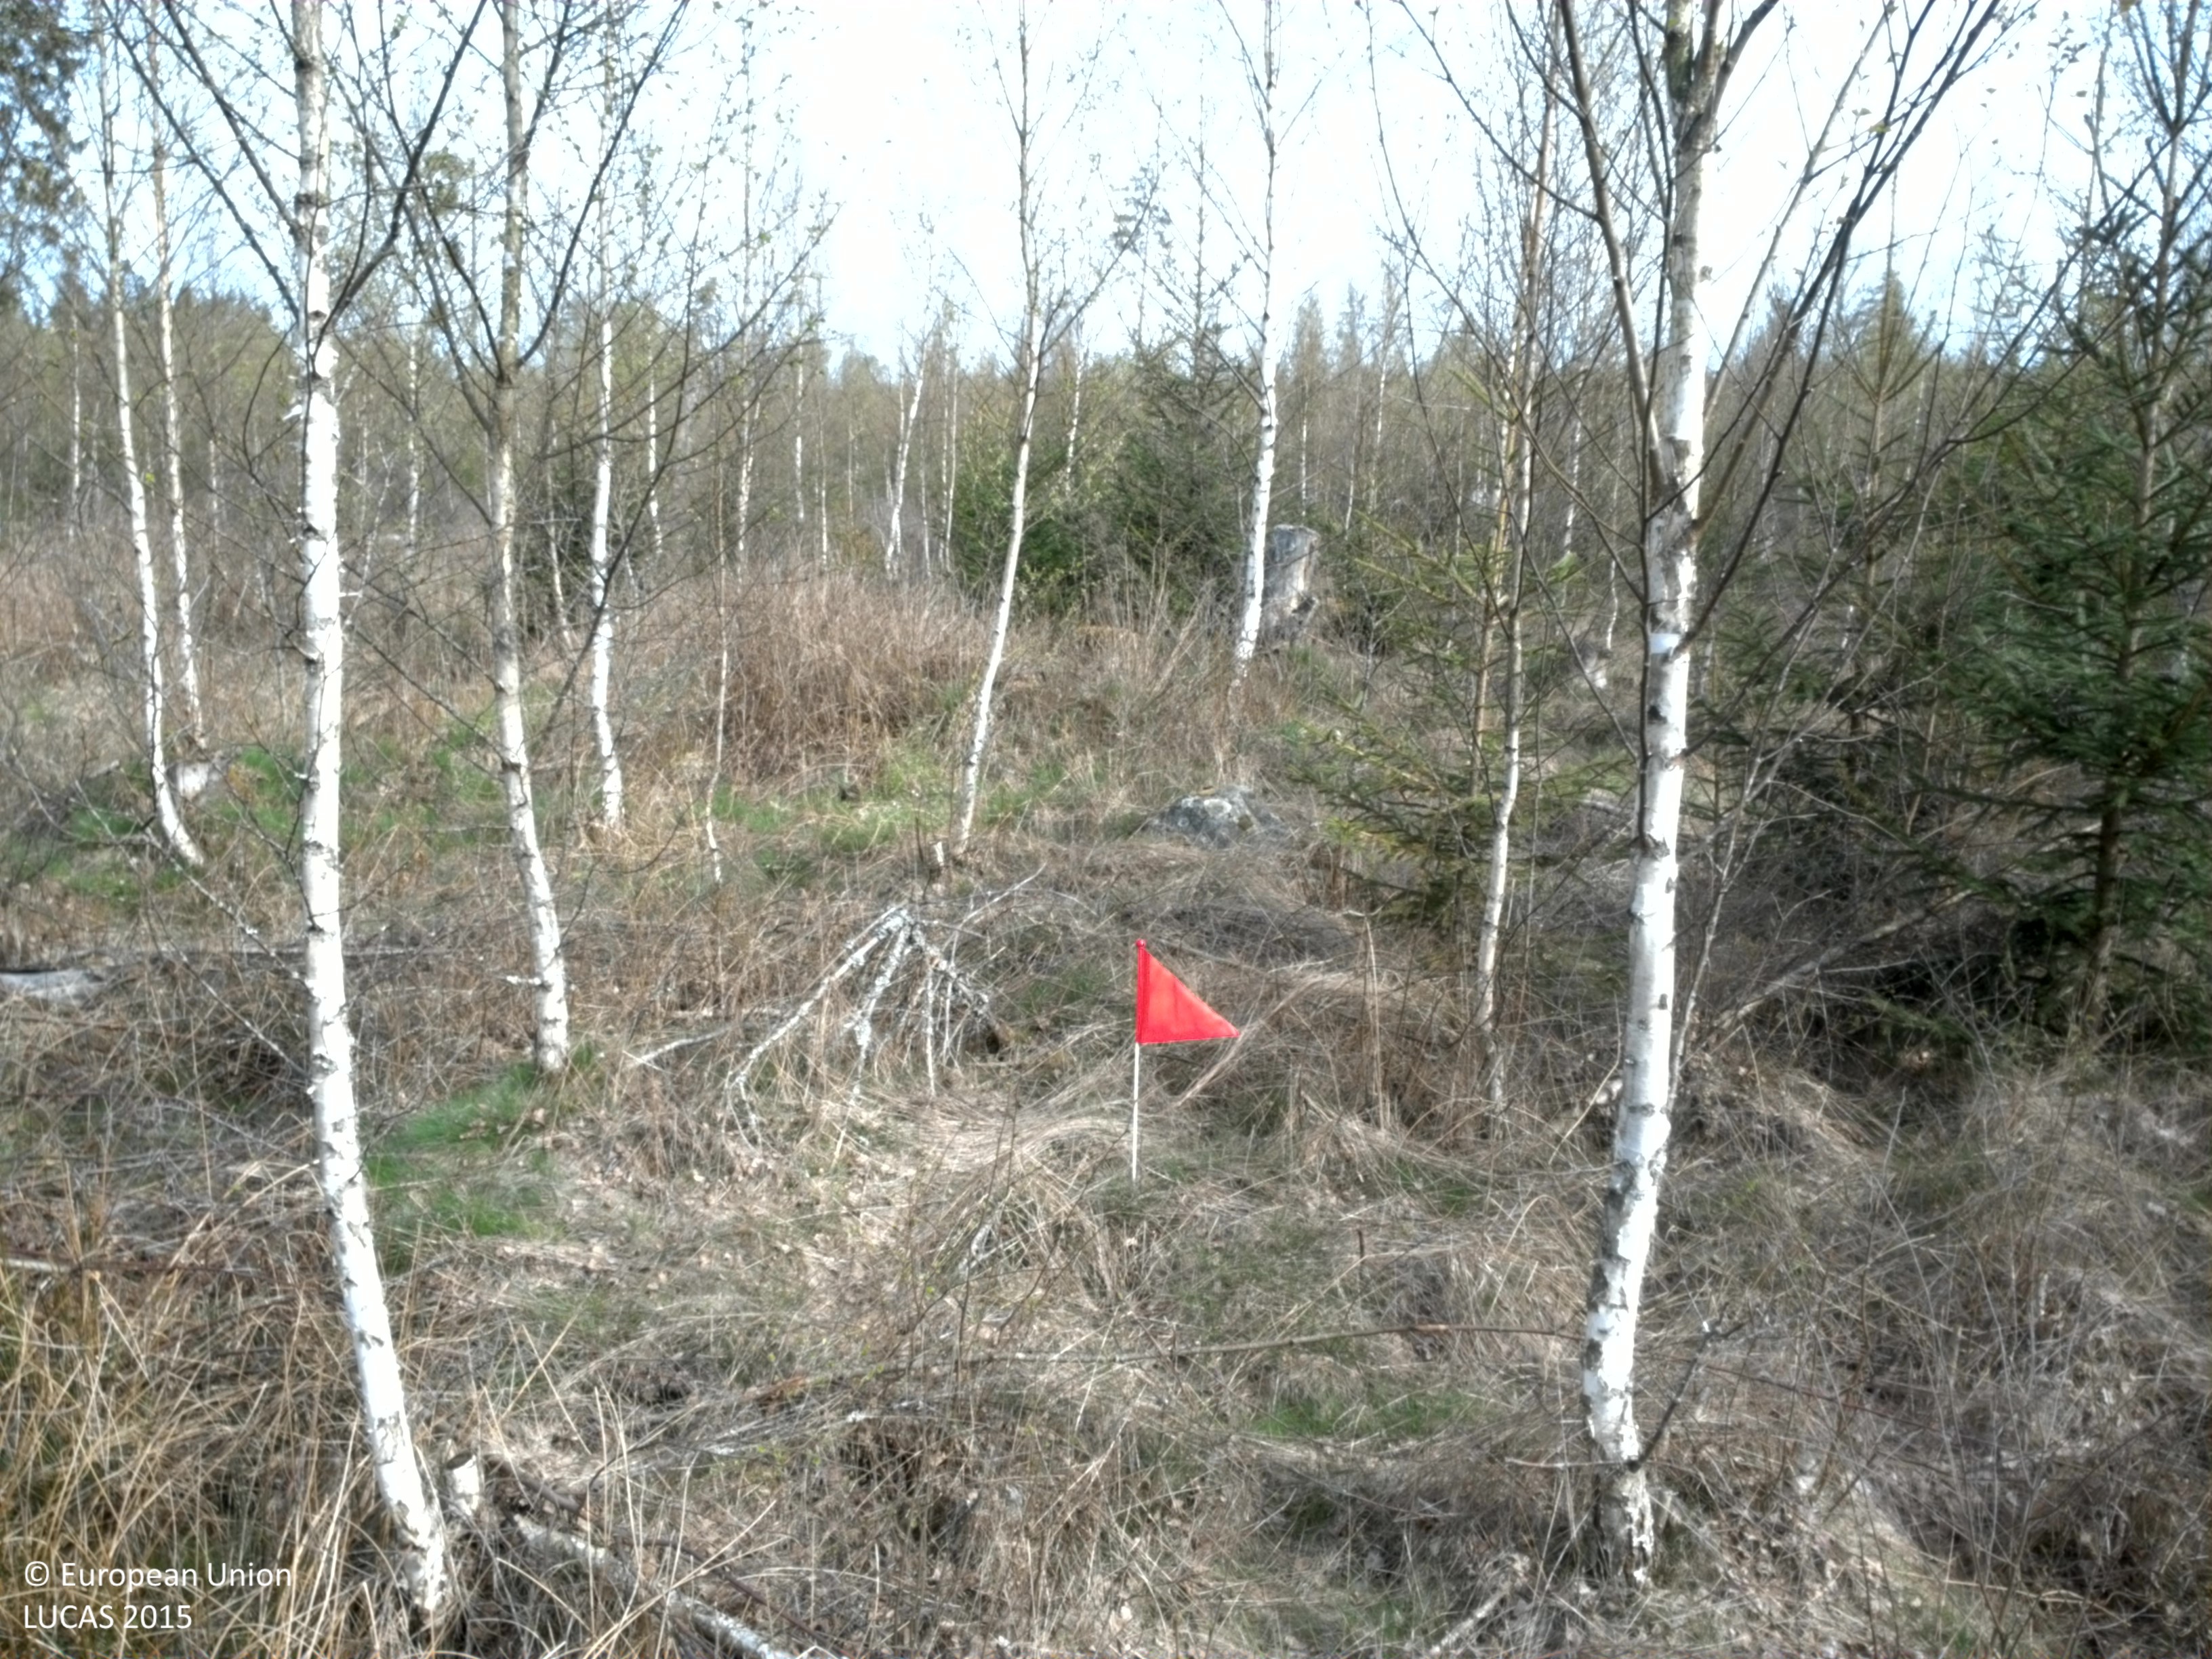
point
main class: Woodland
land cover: Spruce dominated mixed woodland
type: boreal forest
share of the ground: > 75 %
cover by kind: coniferous forest trees 45 %, broadleaved forest trees 45 %
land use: Forestry
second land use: Amenities, museums, leisure
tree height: < 5 m
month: May
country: SE
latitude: 56.7828
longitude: 14.7929
